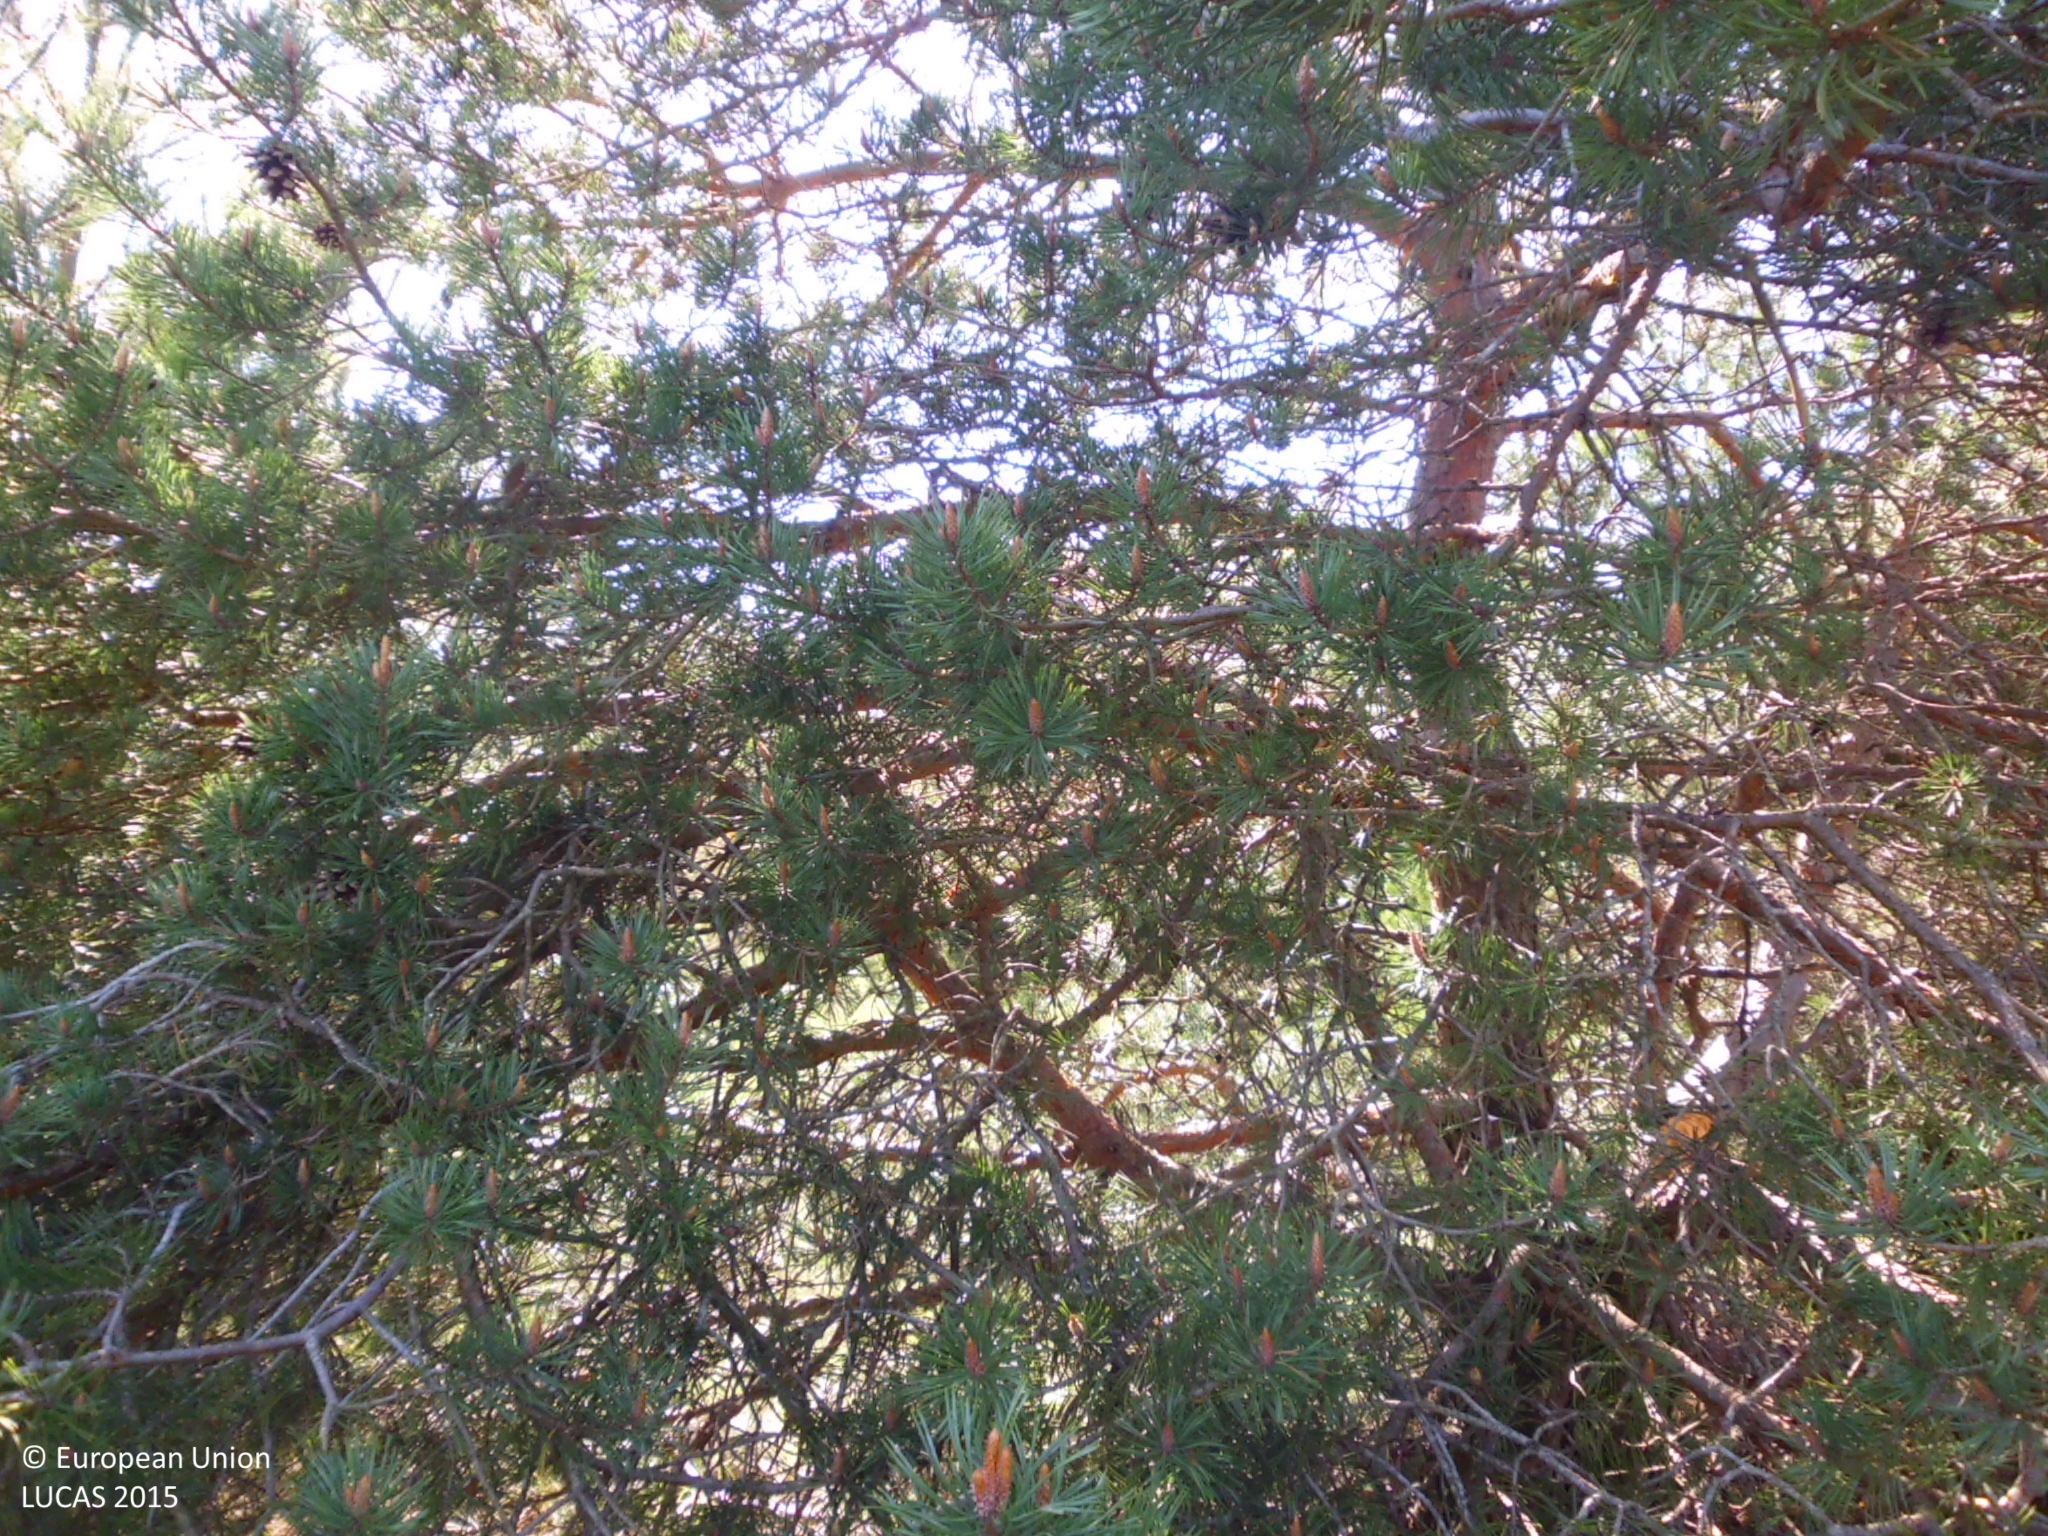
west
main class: Woodland
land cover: Pine dominated coniferous woodland
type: coniferous forest of the mediterranean region
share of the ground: > 75 %
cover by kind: coniferous forest trees 50 %, herbaceous plants 30 %, shrubs 15 %, consolidated bare surface 5 %
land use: Forestry
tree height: < 5 m
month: May
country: ES
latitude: 42.6681
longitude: -3.8415
